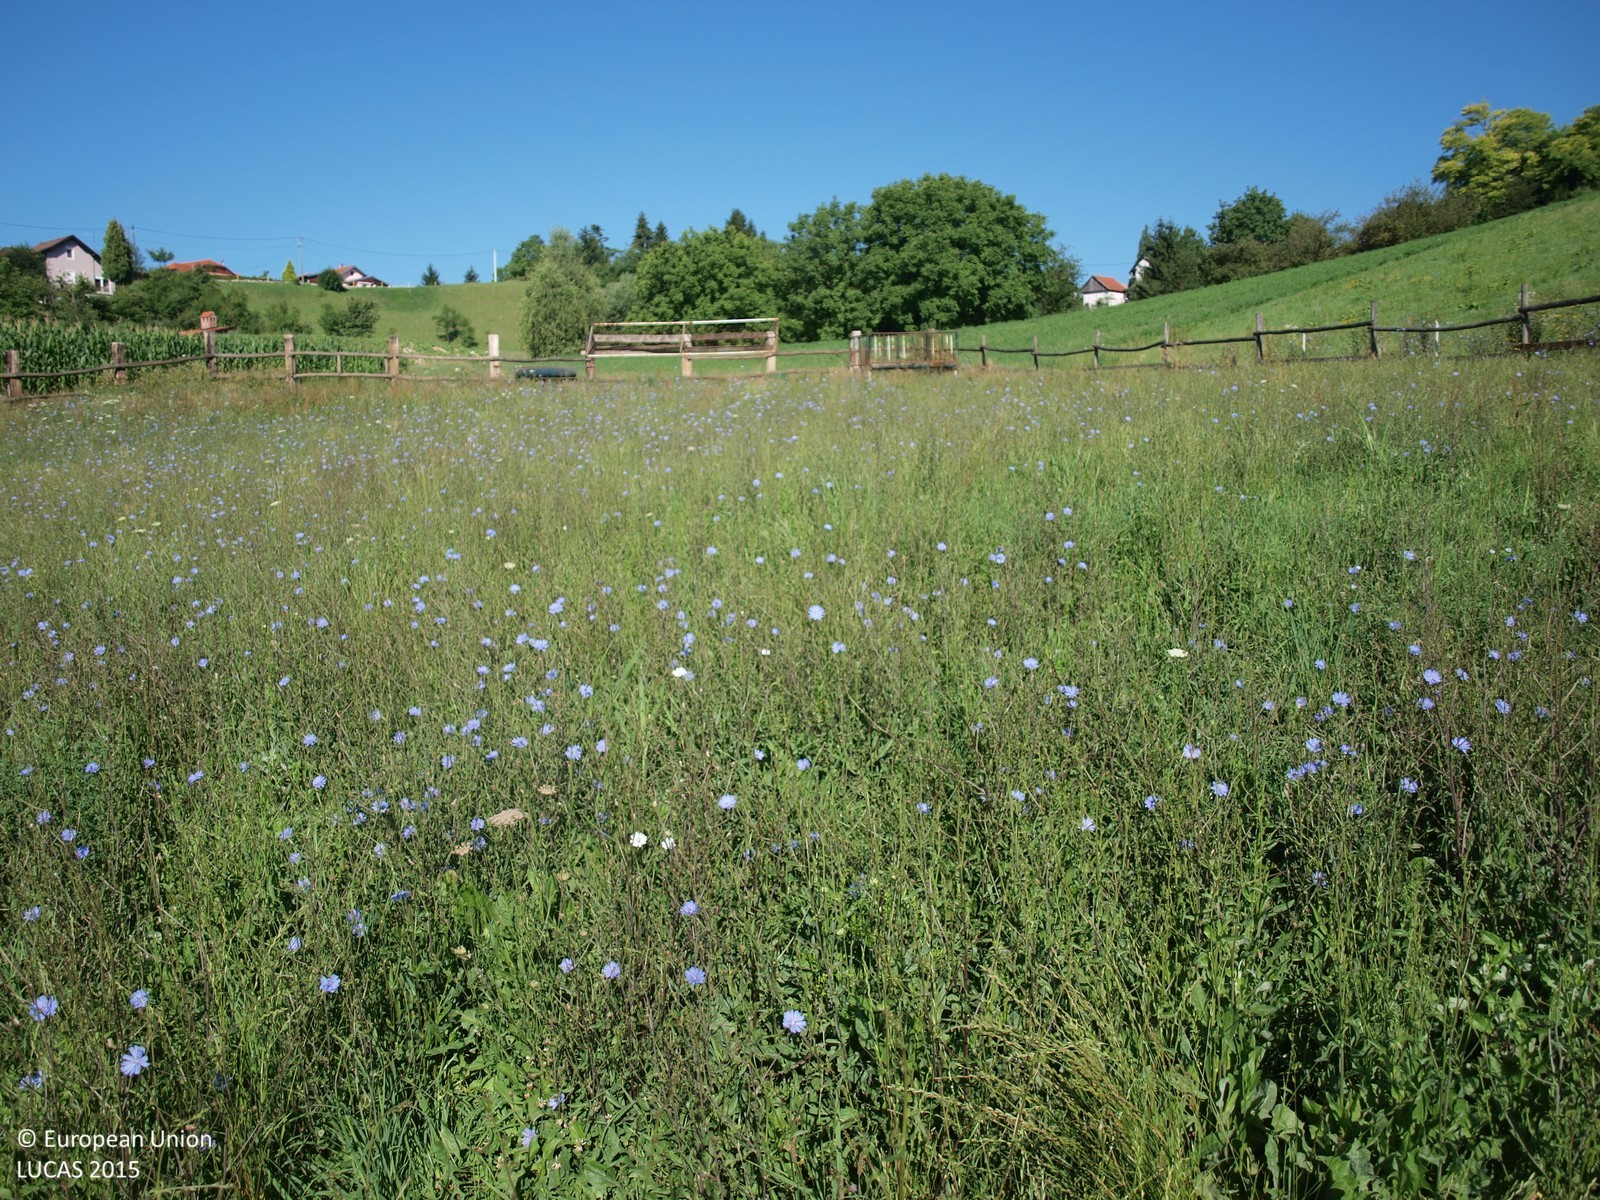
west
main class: Grassland
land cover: Grassland without tree/shrub cover
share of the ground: > 75 %
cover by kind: herbaceous plants 100 %
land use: Agriculture (excluding fallow land and kitchen gardens)
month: July
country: HR
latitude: 45.8919
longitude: 15.7067
